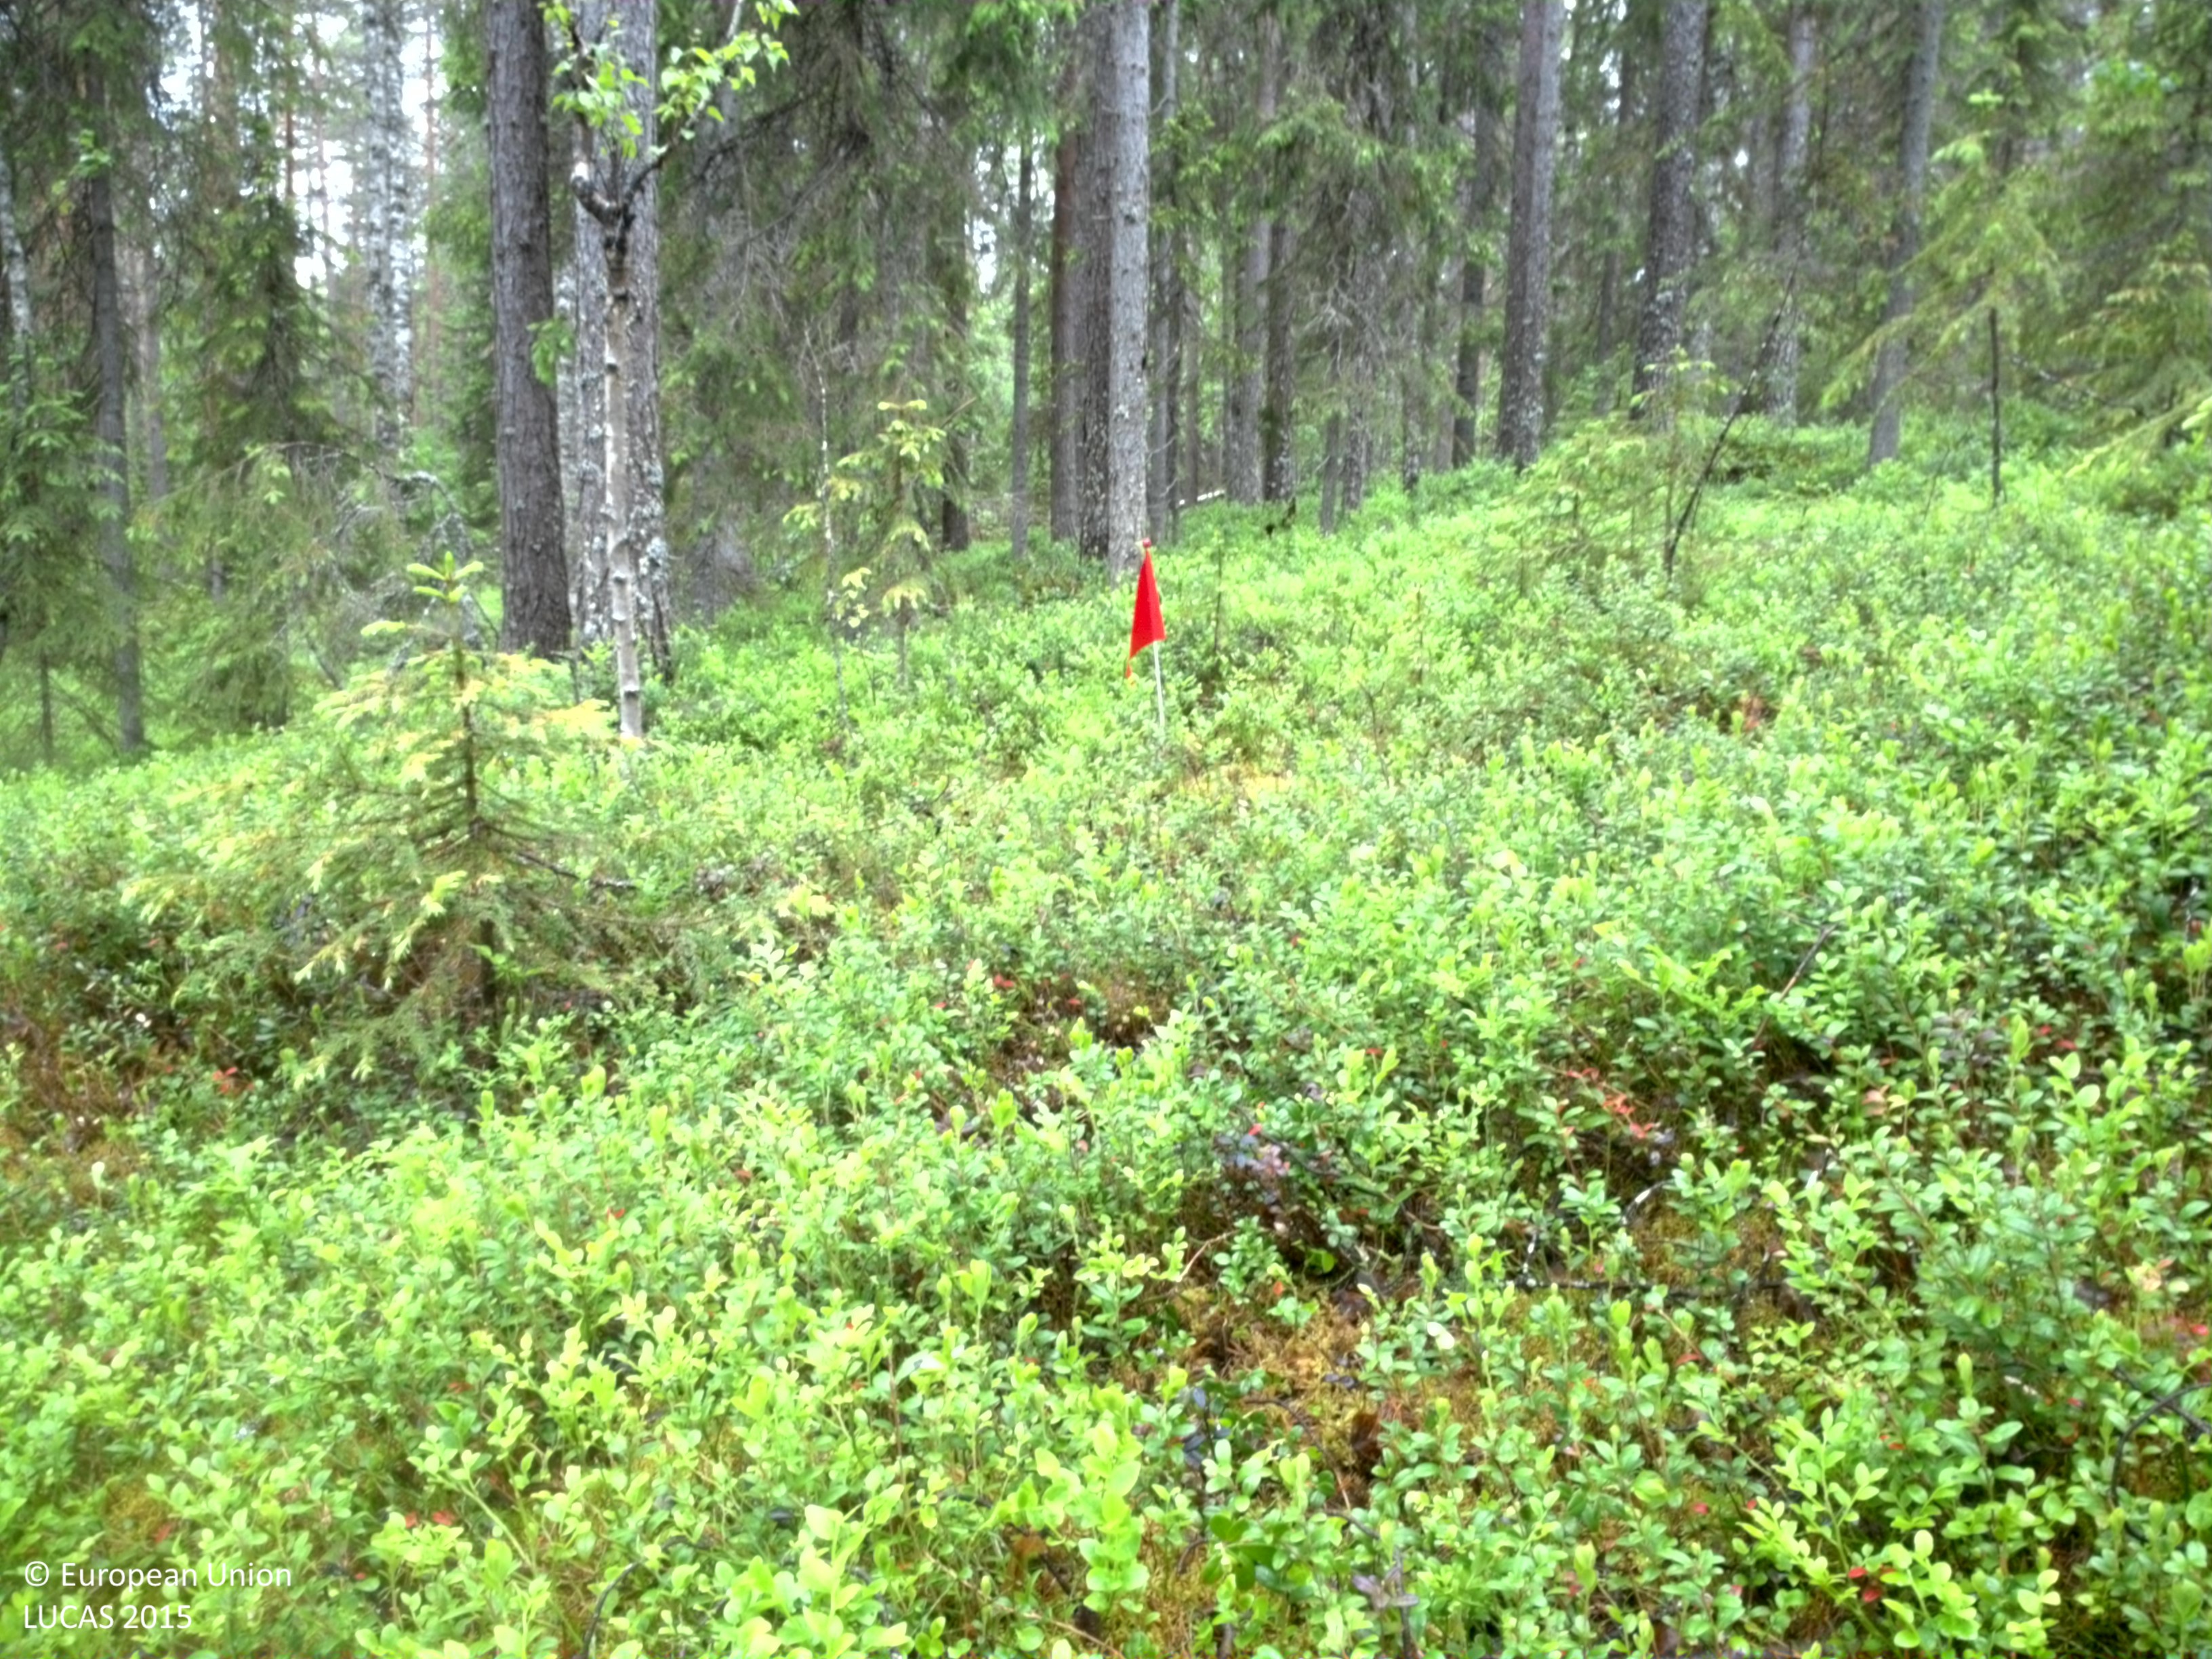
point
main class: Woodland
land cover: Pine dominated coniferous woodland
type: boreal forest
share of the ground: 50 - 75 %
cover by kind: coniferous forest trees 45 %, shrubs 45 %, broadleaved forest trees 10 %
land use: Forestry
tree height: > 5 m
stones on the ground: 10 - 25 %
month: June
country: SE
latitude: 66.4713
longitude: 22.7479
